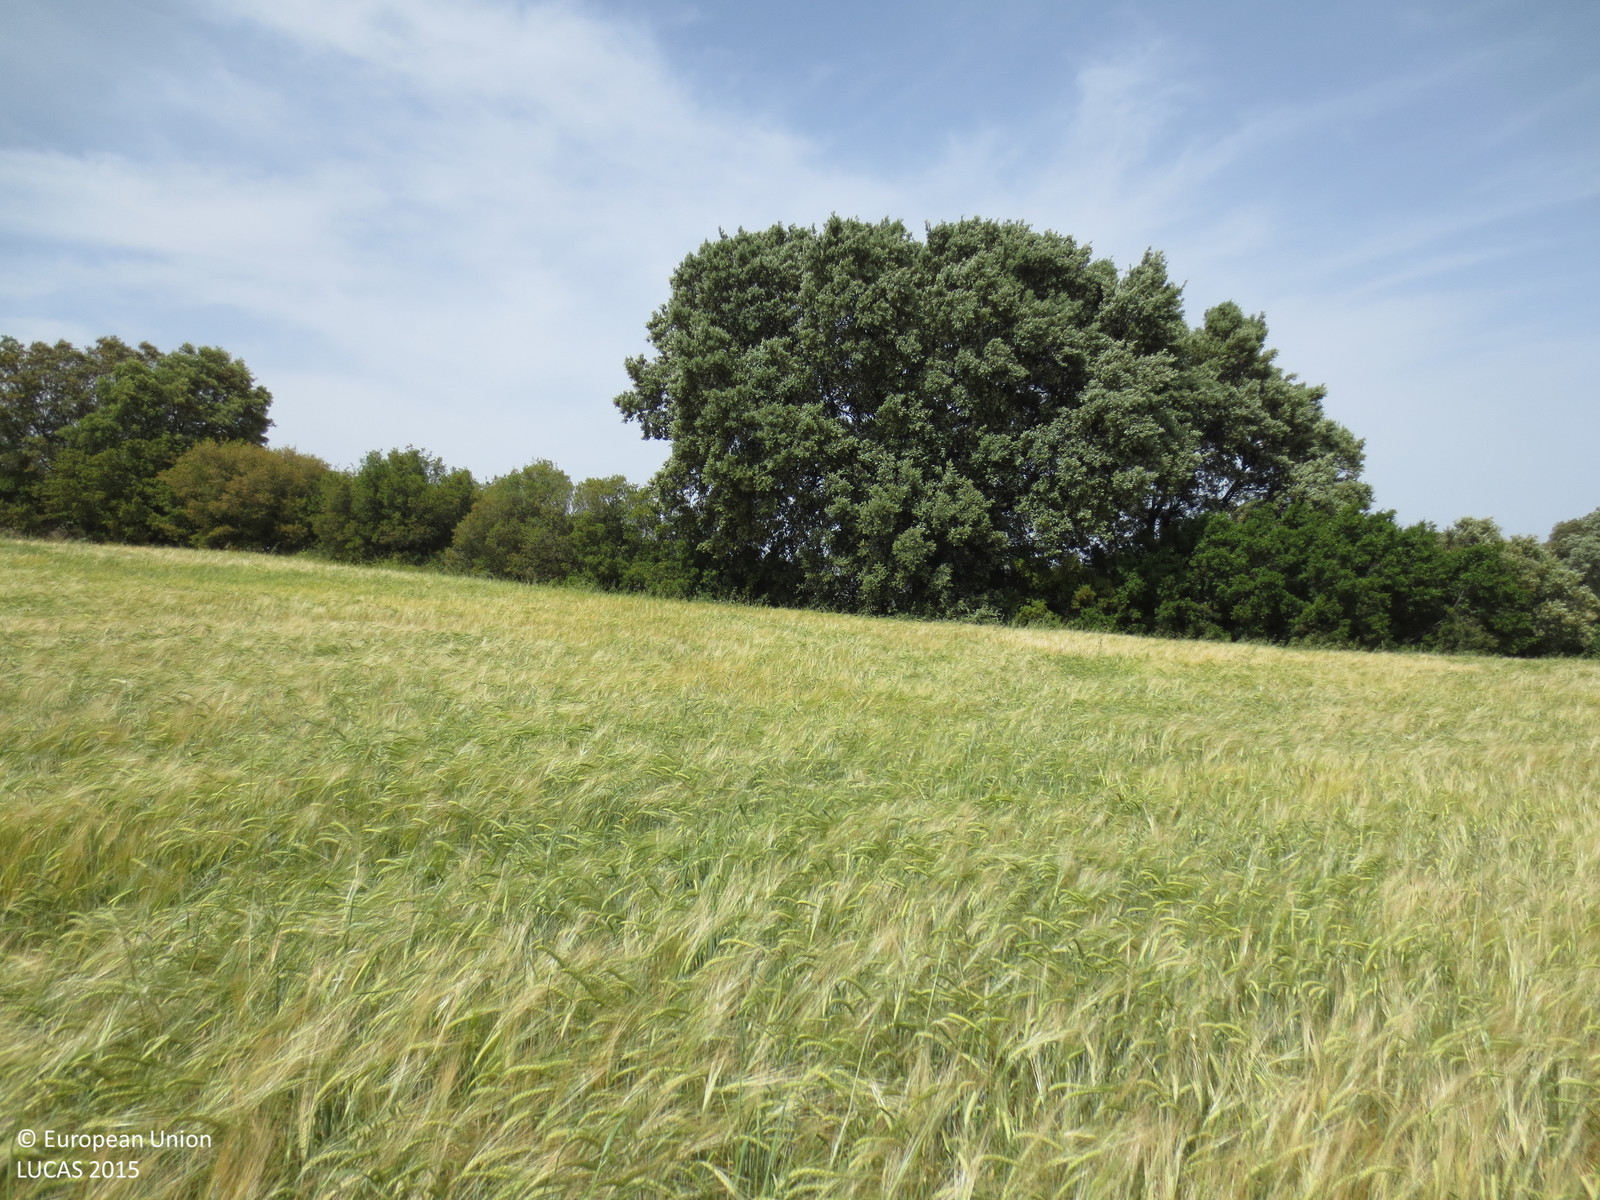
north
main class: Cropland
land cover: Barley
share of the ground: > 75 %
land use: Agriculture (excluding fallow land and kitchen gardens)
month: May
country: ES
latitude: 40.4236
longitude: -2.5768
